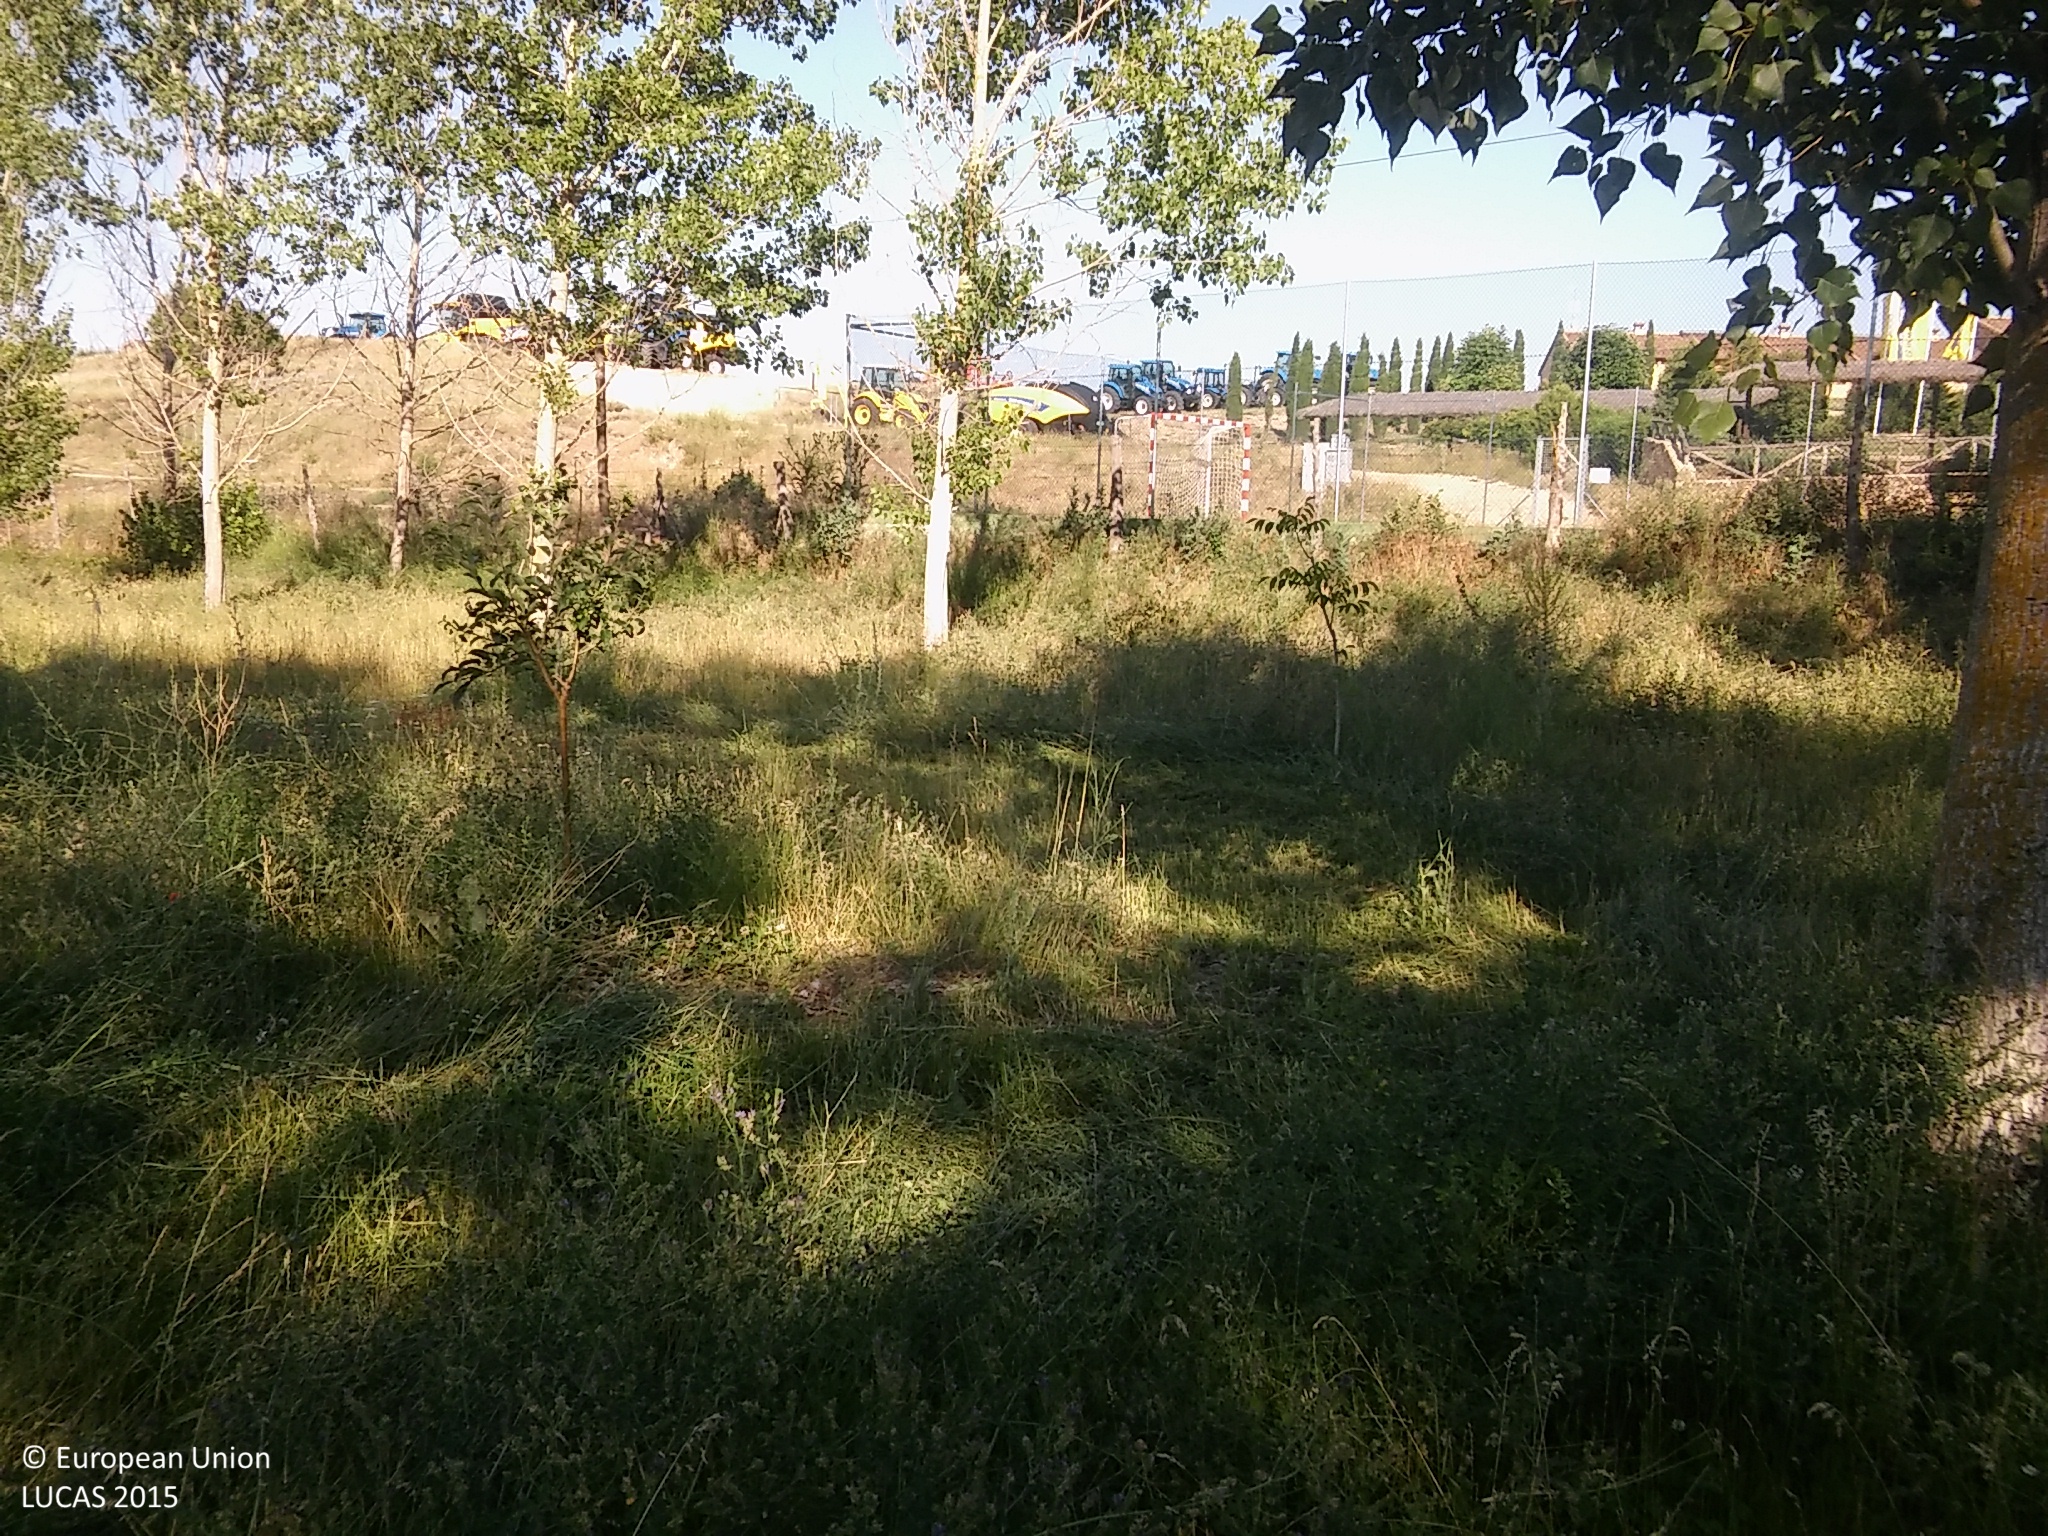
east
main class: Woodland
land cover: Broadleaved woodland
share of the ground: 10 - 25 %
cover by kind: herbaceous plants 80 %, broadleaved forest trees 20 %
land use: Forestry
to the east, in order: Broadleaved woodland; Apple fruit; Grassland with sparse tree/shrub cover; Fences; Spontaneously vegetated surfaces; Tracks; Grass margins; Dry stone walls; Grassland without tree/shrub cover; Groves; Grass margins; Tracks; Grassland without tree/shrub cover; Tracks; Grassland without tree/shrub cover; Other bare soil; Grass margins; Tracks
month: June
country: ES
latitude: 41.0960
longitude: -4.0886
